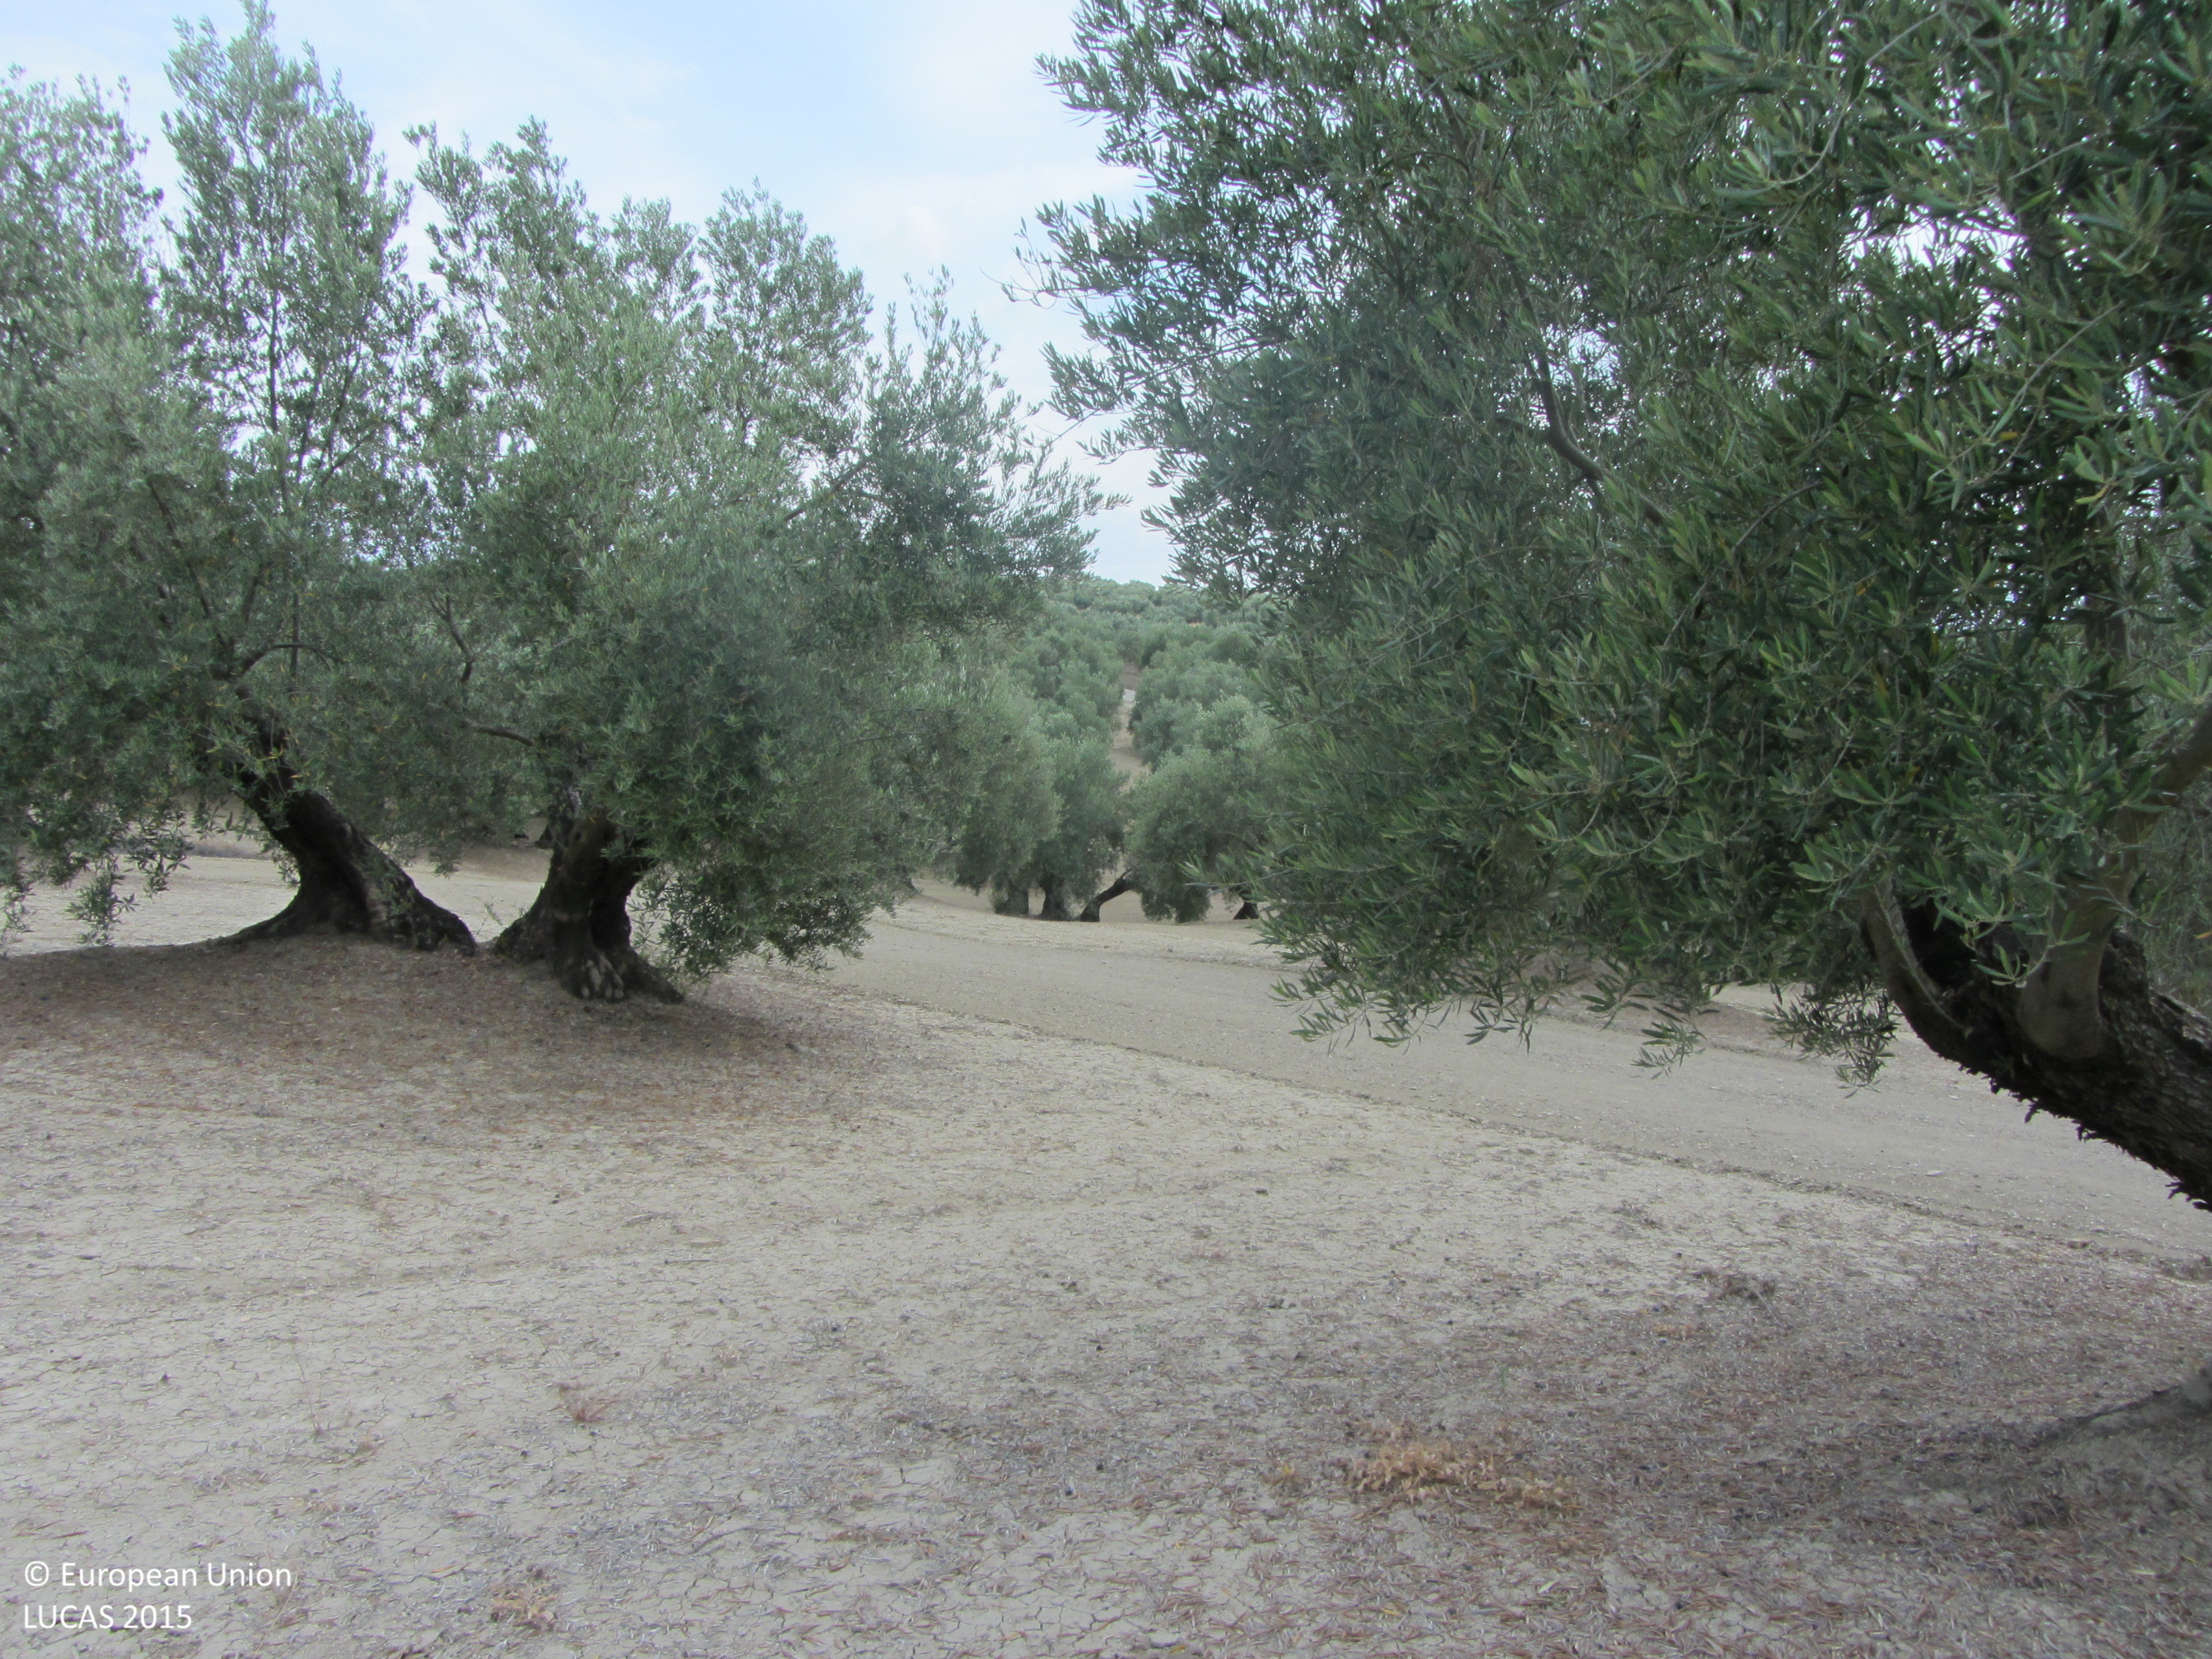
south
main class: Cropland
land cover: Olive groves
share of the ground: 25 - 50 %
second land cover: Other bare soil
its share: > 75 %
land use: Agriculture (excluding fallow land and kitchen gardens)
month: June
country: ES
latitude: 38.0060
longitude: -3.2670
